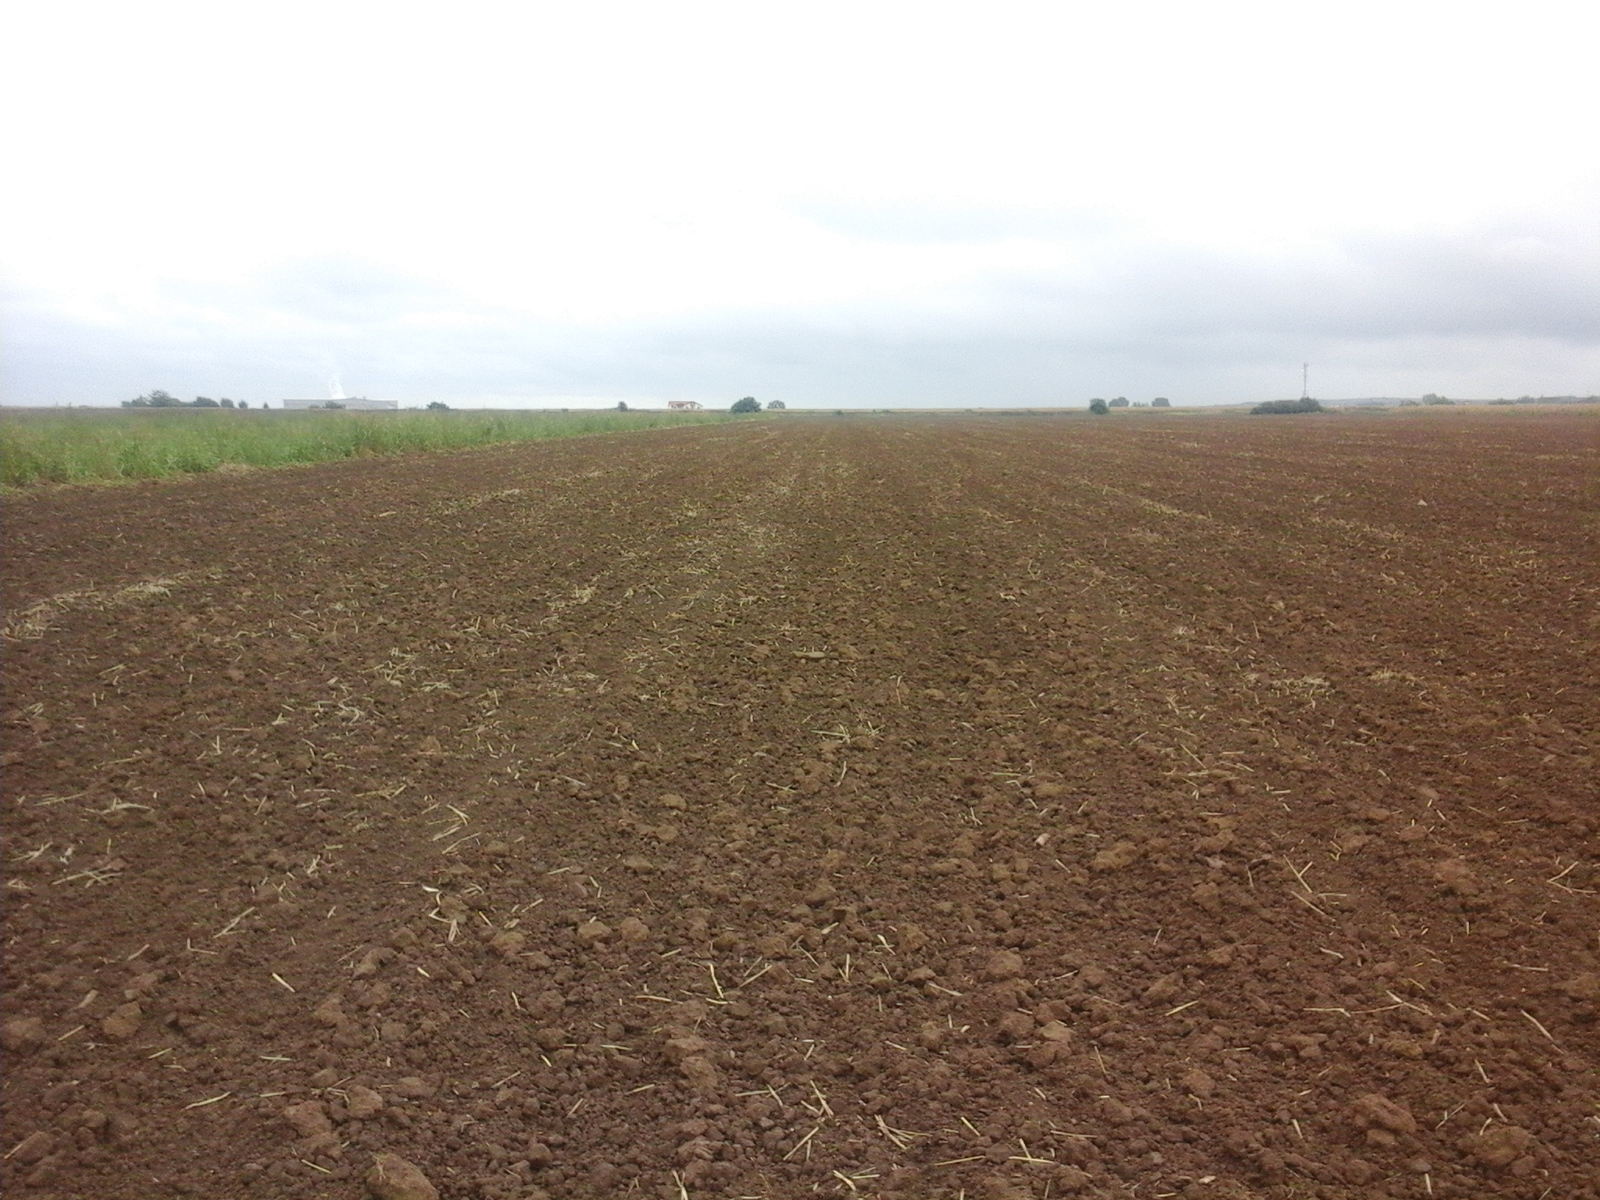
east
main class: Cropland
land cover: Common wheat
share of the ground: < 10 %
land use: Agriculture (excluding fallow land and kitchen gardens)
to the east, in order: Common wheat; Sugar beet
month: September
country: RO
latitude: 47.1753
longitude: 21.9083
